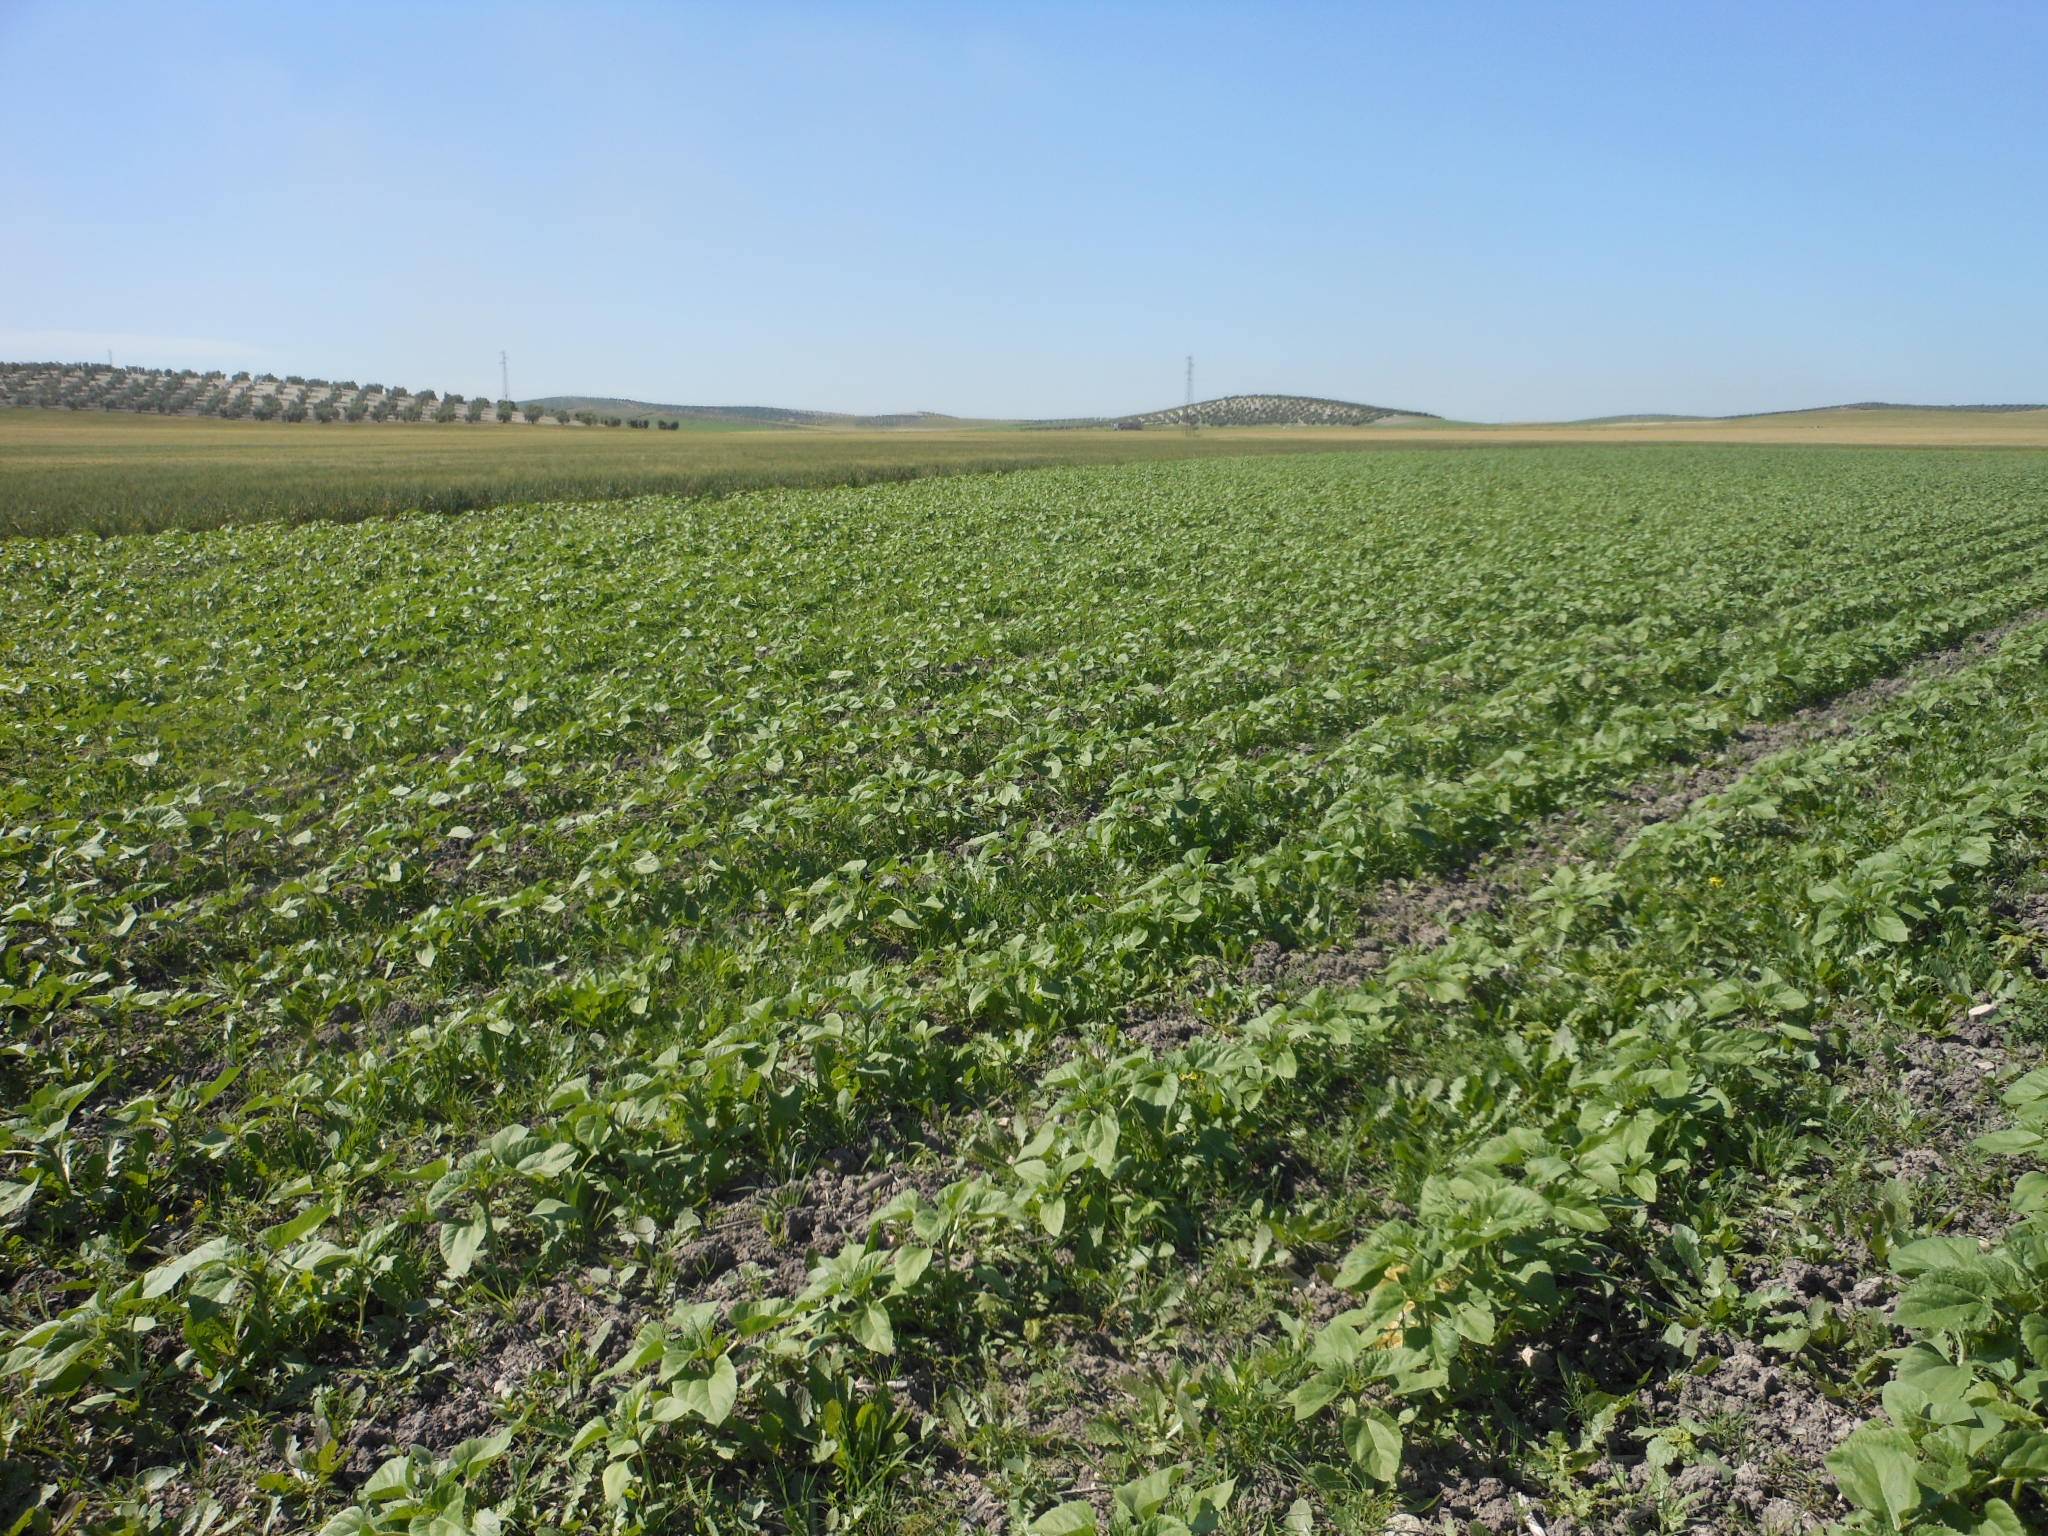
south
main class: Cropland
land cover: Sunflower
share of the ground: 25 - 50 %
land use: Agriculture (excluding fallow land and kitchen gardens)
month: April
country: ES
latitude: 37.3751
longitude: -5.4751
